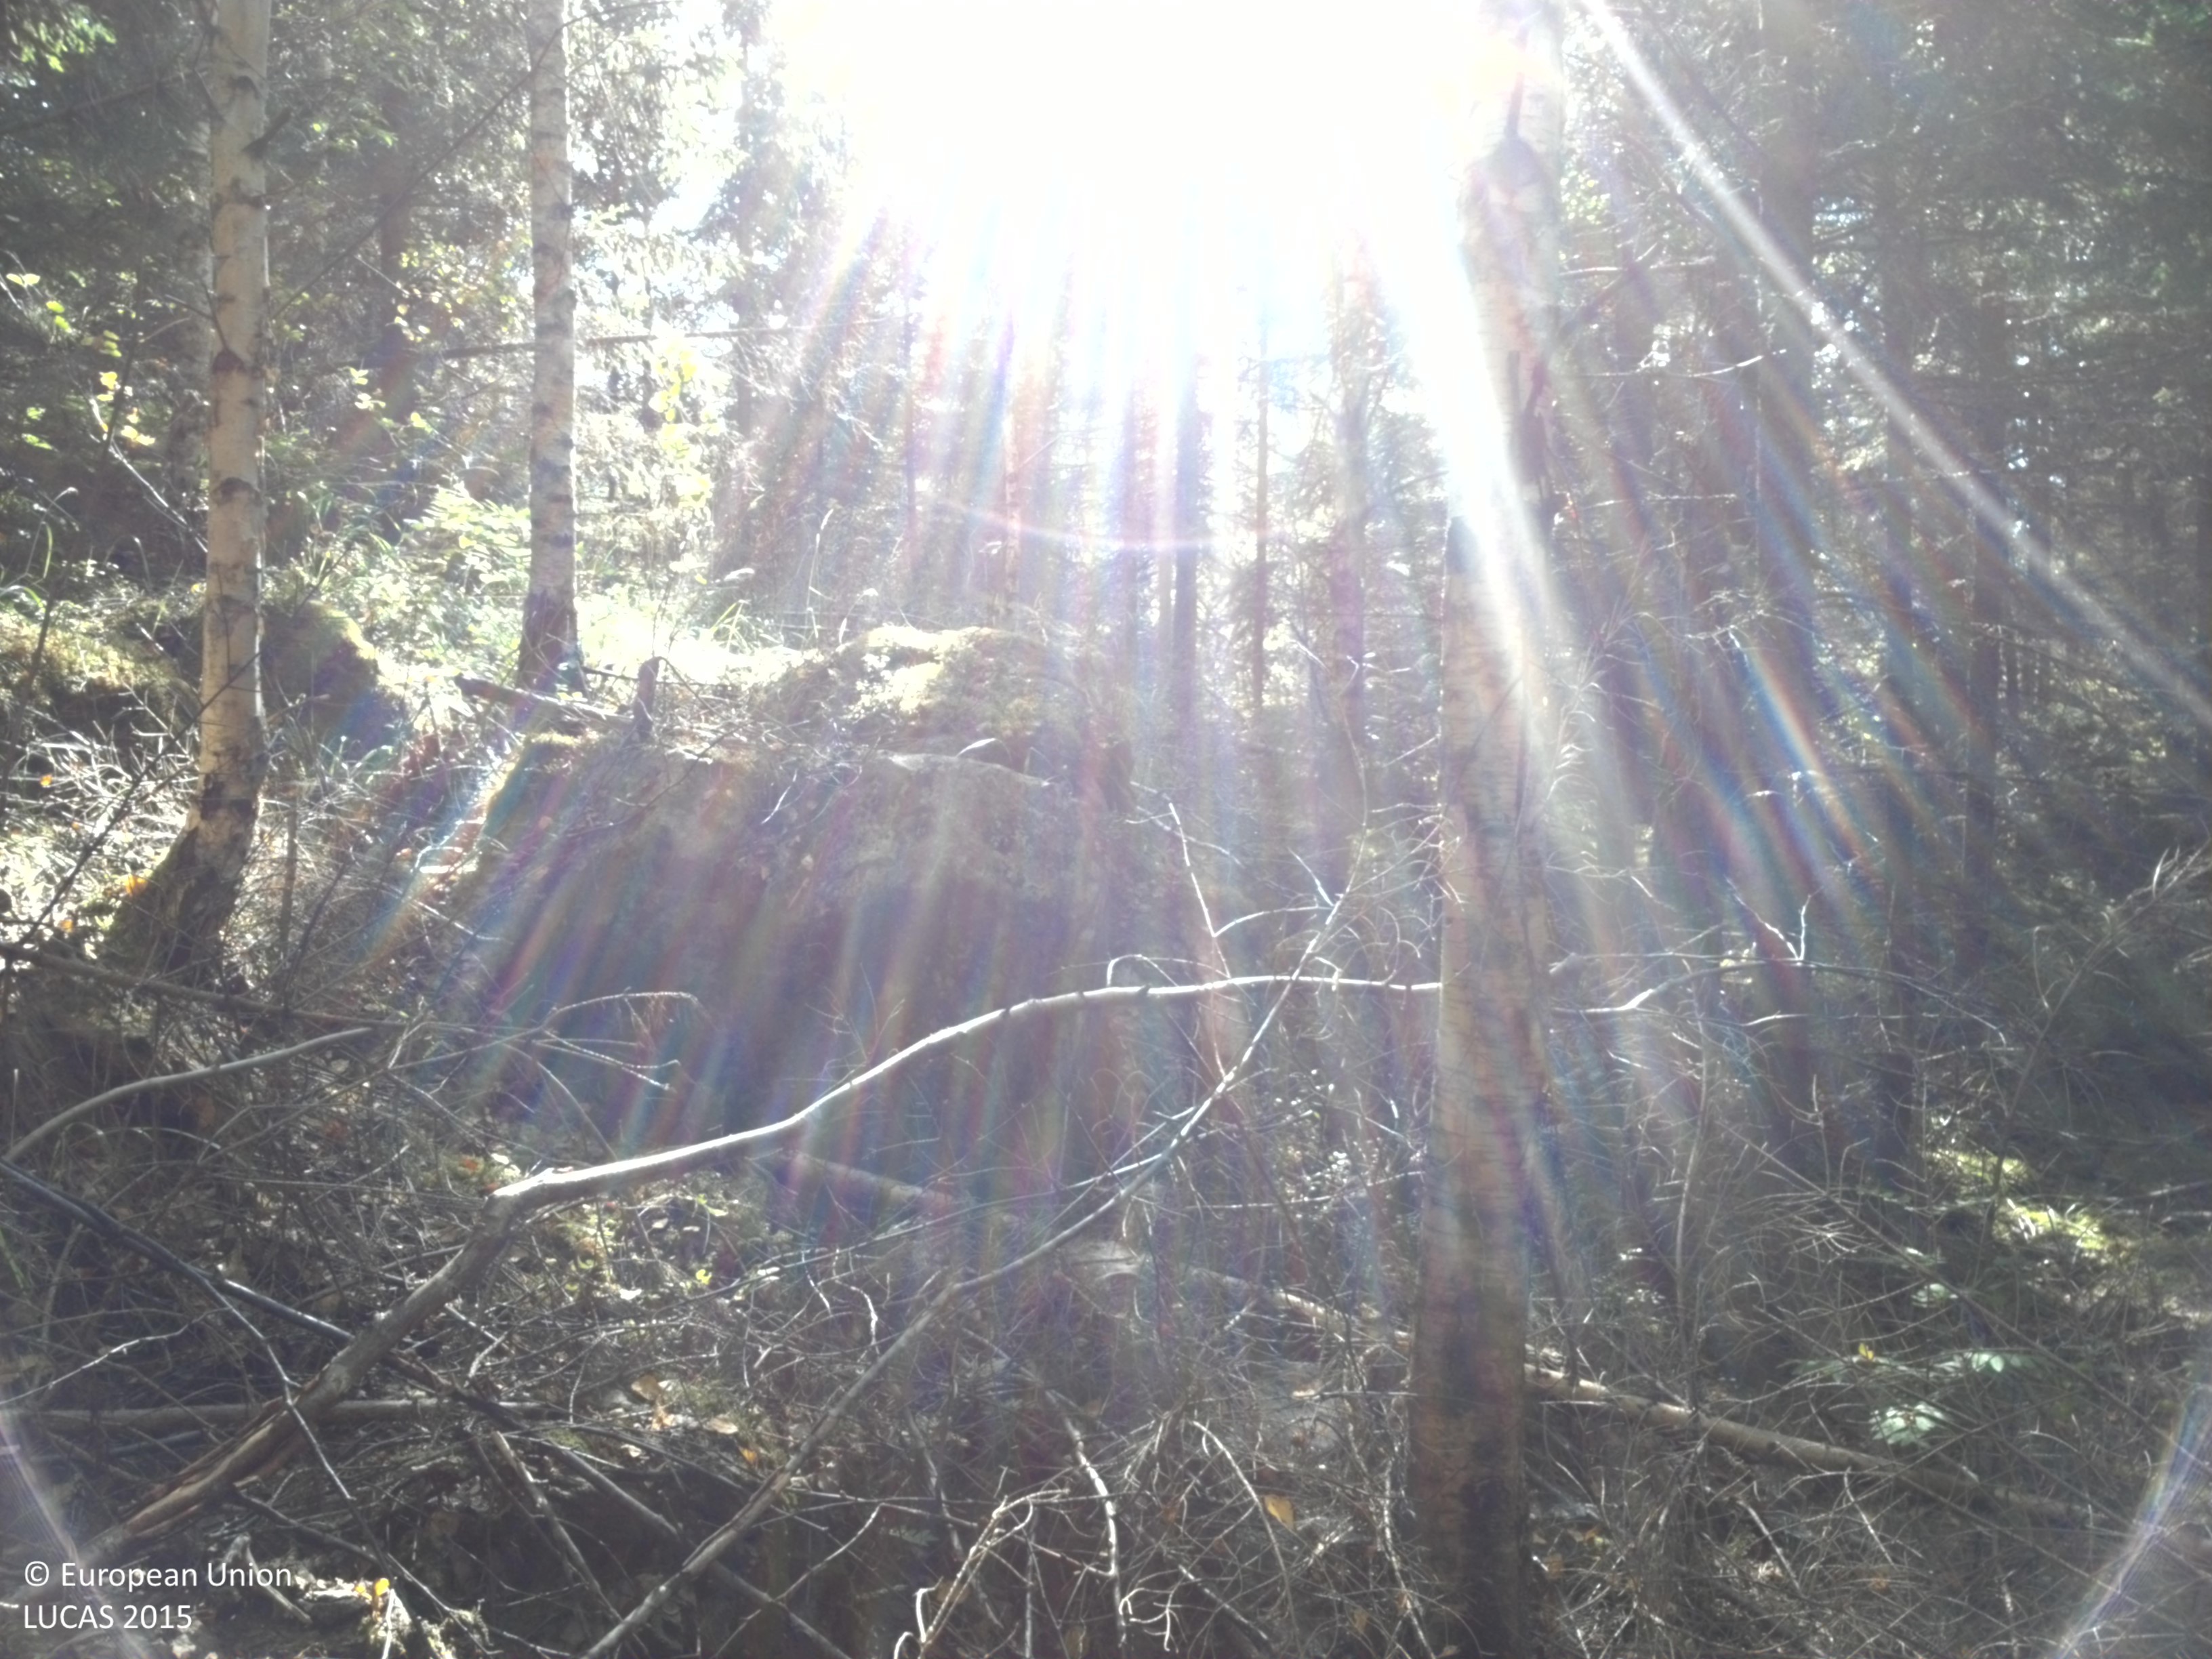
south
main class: Woodland
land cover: Spruce dominated coniferous woodland
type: boreal forest
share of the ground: > 75 %
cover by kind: coniferous forest trees 80 %, broadleaved forest trees 10 %, lichens and mosses 5 %, unconsolidated bare surface 5 %
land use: Forestry
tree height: > 5 m
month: August
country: SE
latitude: 60.0727
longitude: 17.8108
